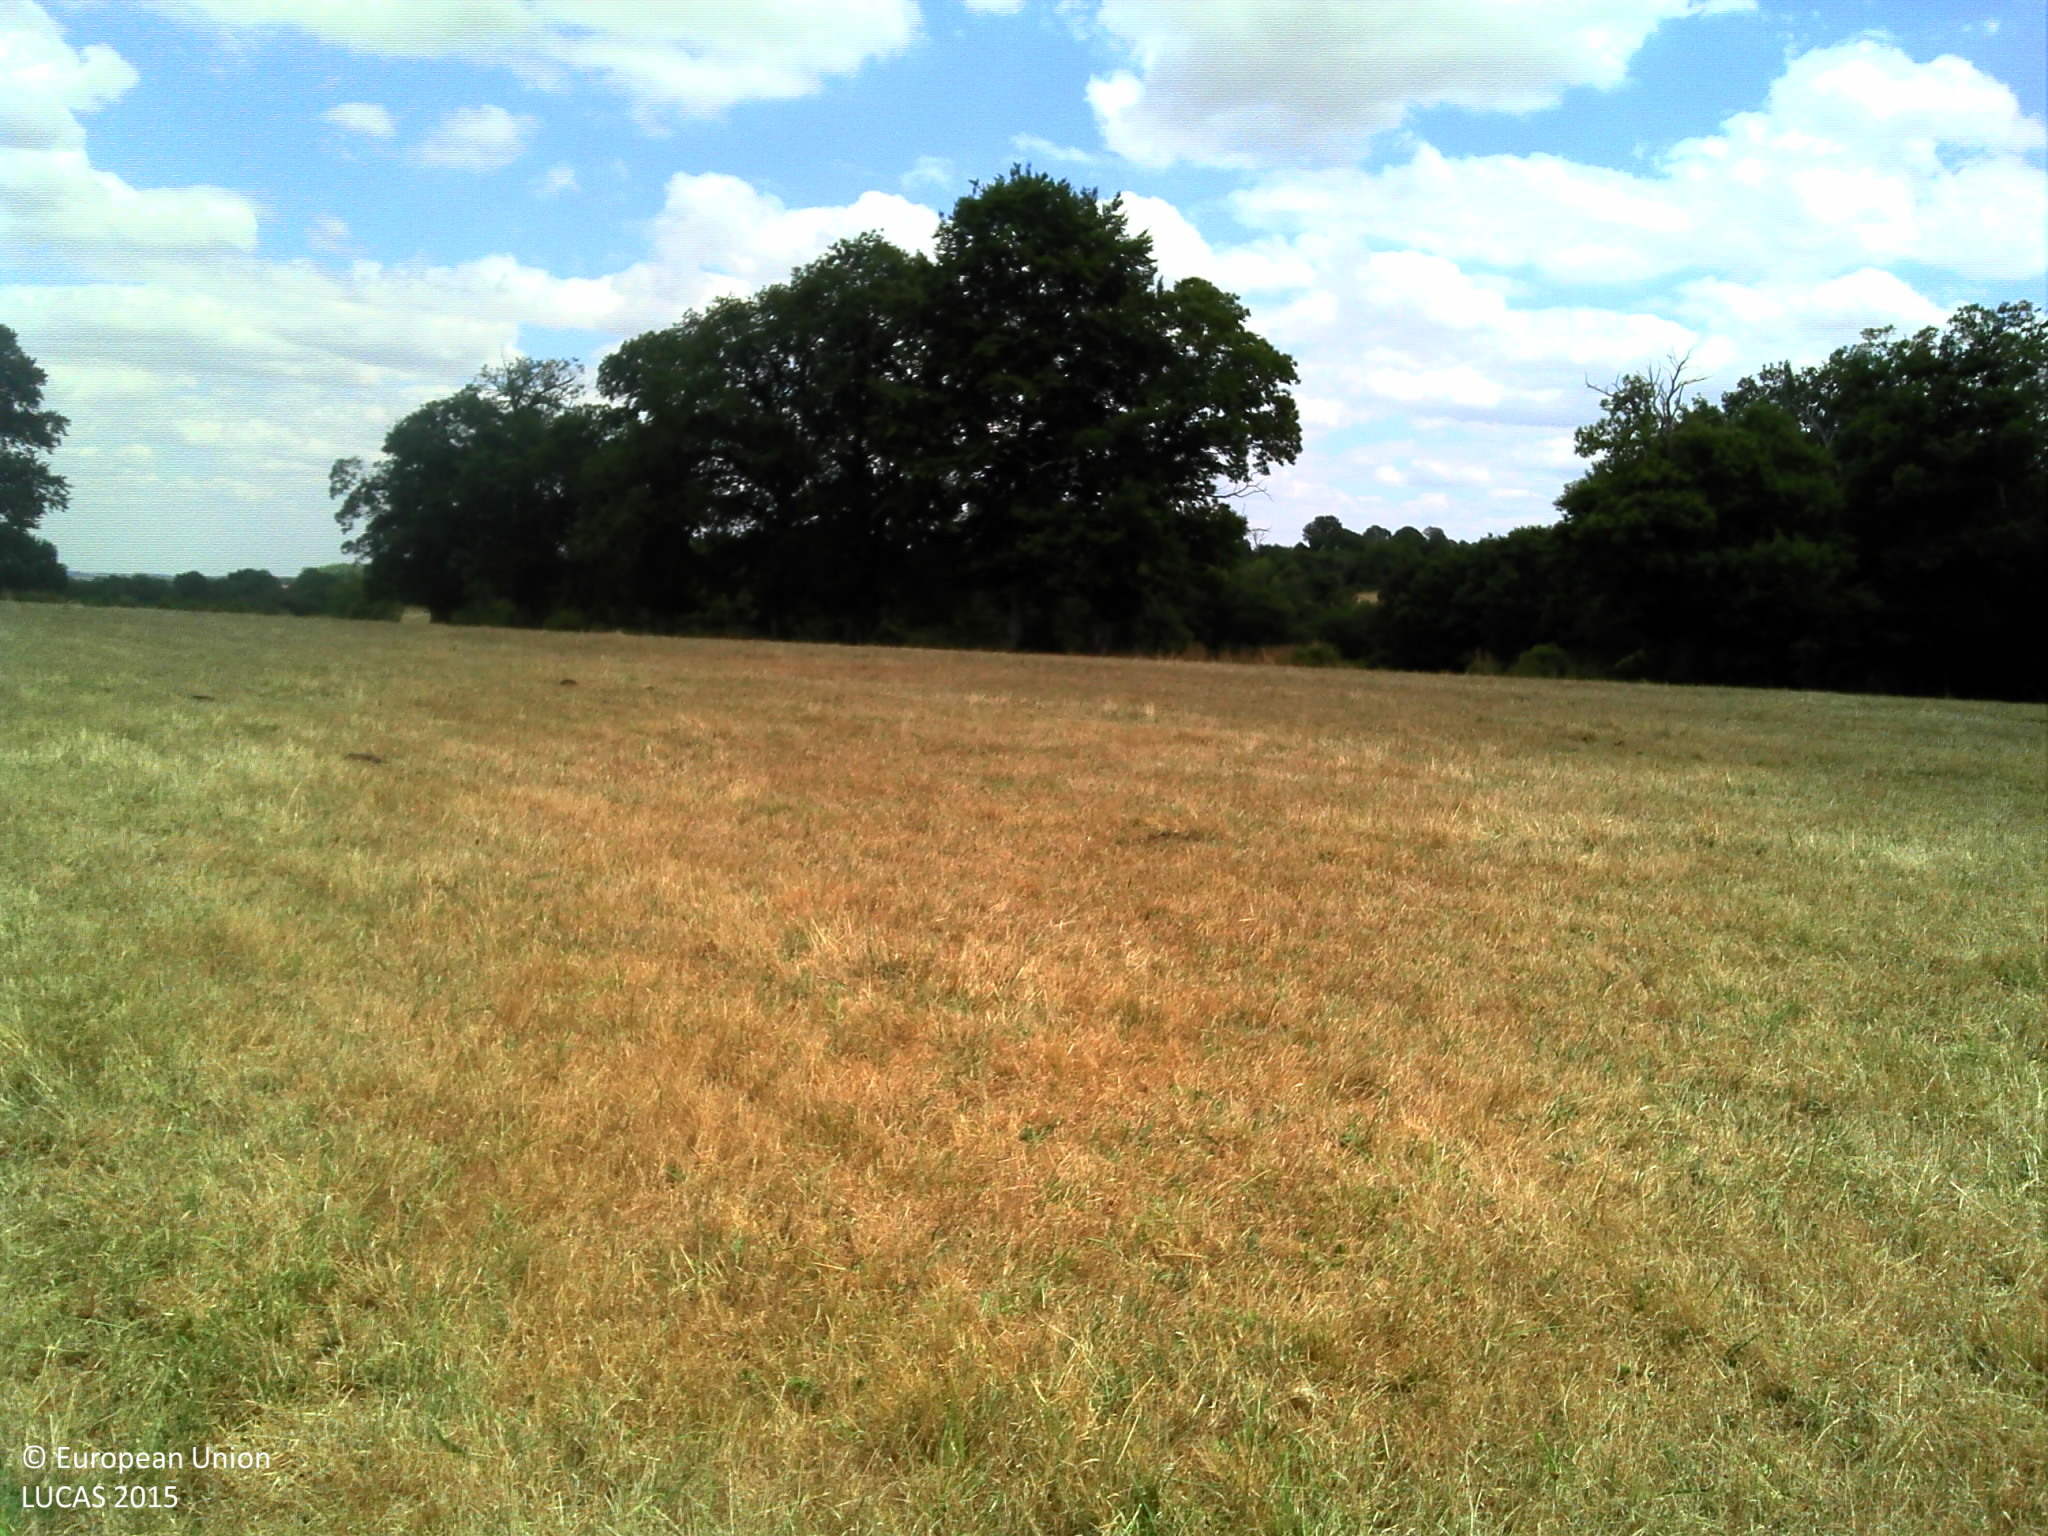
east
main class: Grassland
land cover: Grassland without tree/shrub cover
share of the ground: > 75 %
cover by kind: herbaceous plants 100 %
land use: Agriculture (excluding fallow land and kitchen gardens)
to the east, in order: Grassland without tree/shrub cover; Lines of trees; Grassland without tree/shrub cover
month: July
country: FR
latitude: 46.4297
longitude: 2.2249
